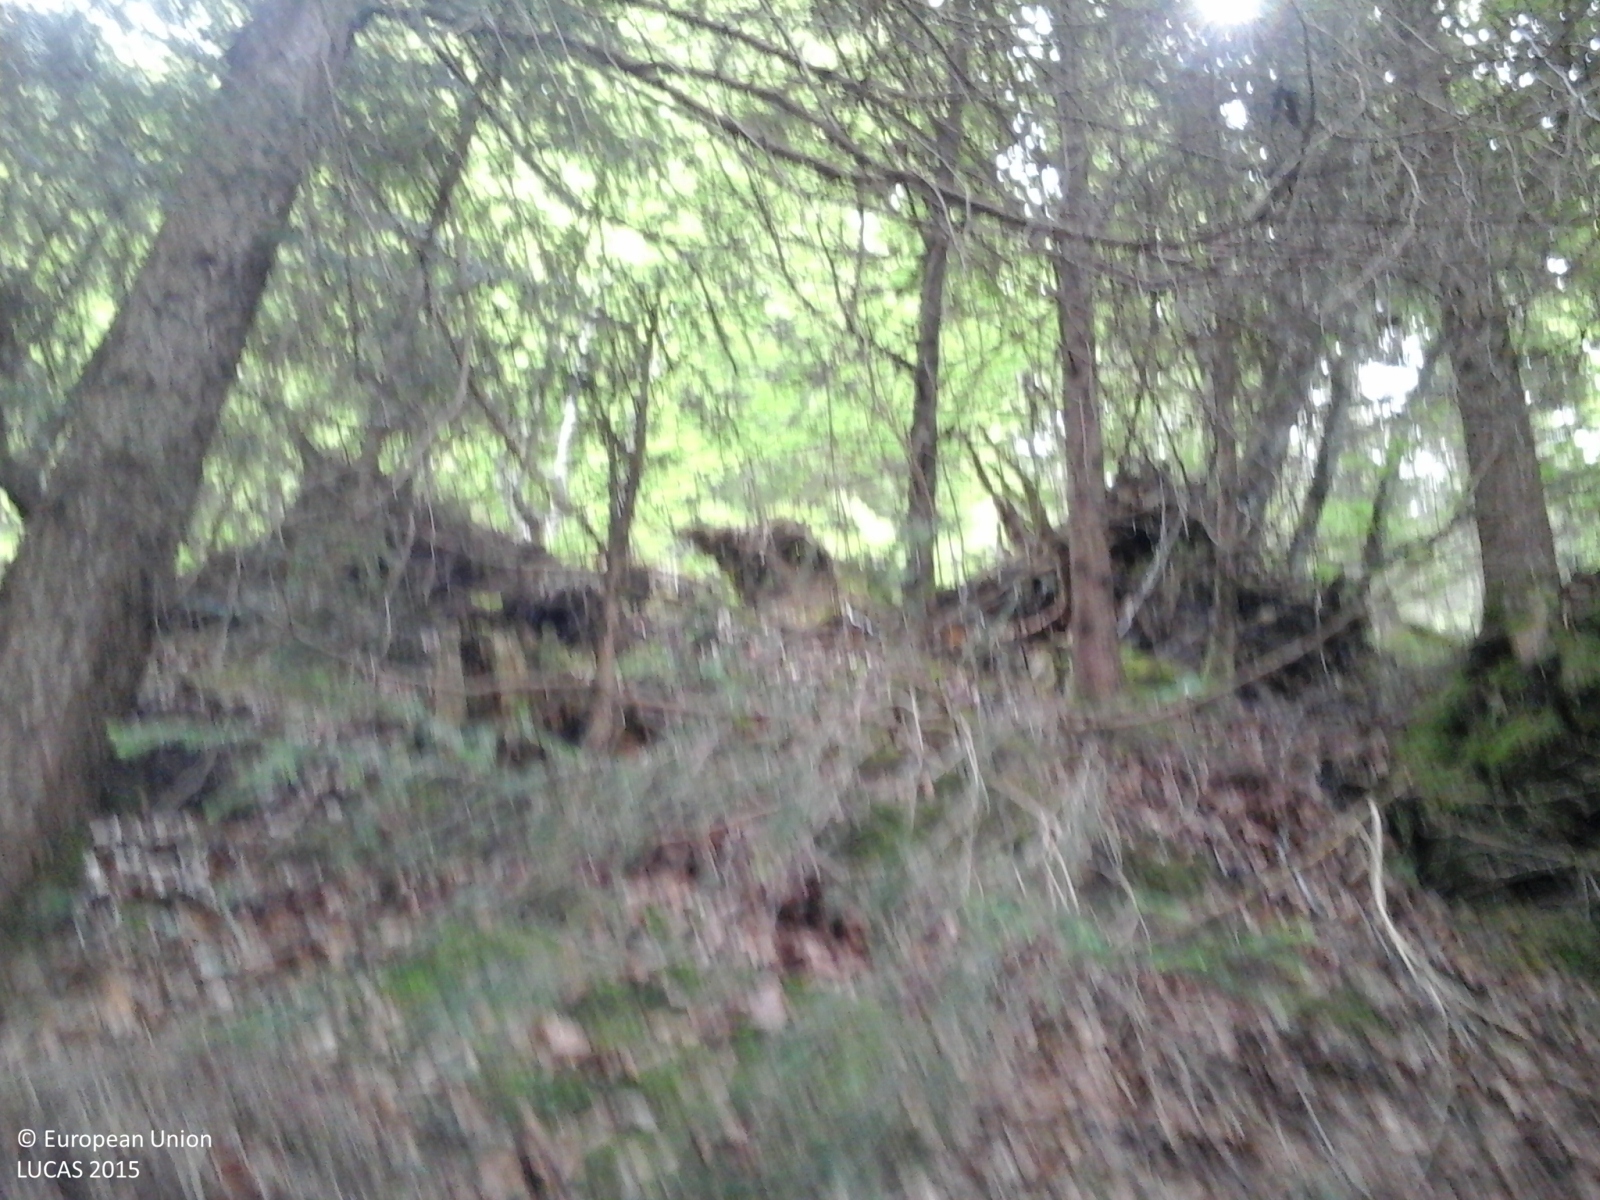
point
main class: Woodland
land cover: Spruce dominated mixed woodland
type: alpine coniferous forest
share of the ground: > 75 %
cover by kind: coniferous forest trees 75 %, broadleaved forest trees 25 %
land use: Forestry
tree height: > 5 m
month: May
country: IT
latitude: 46.2086
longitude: 11.8770
